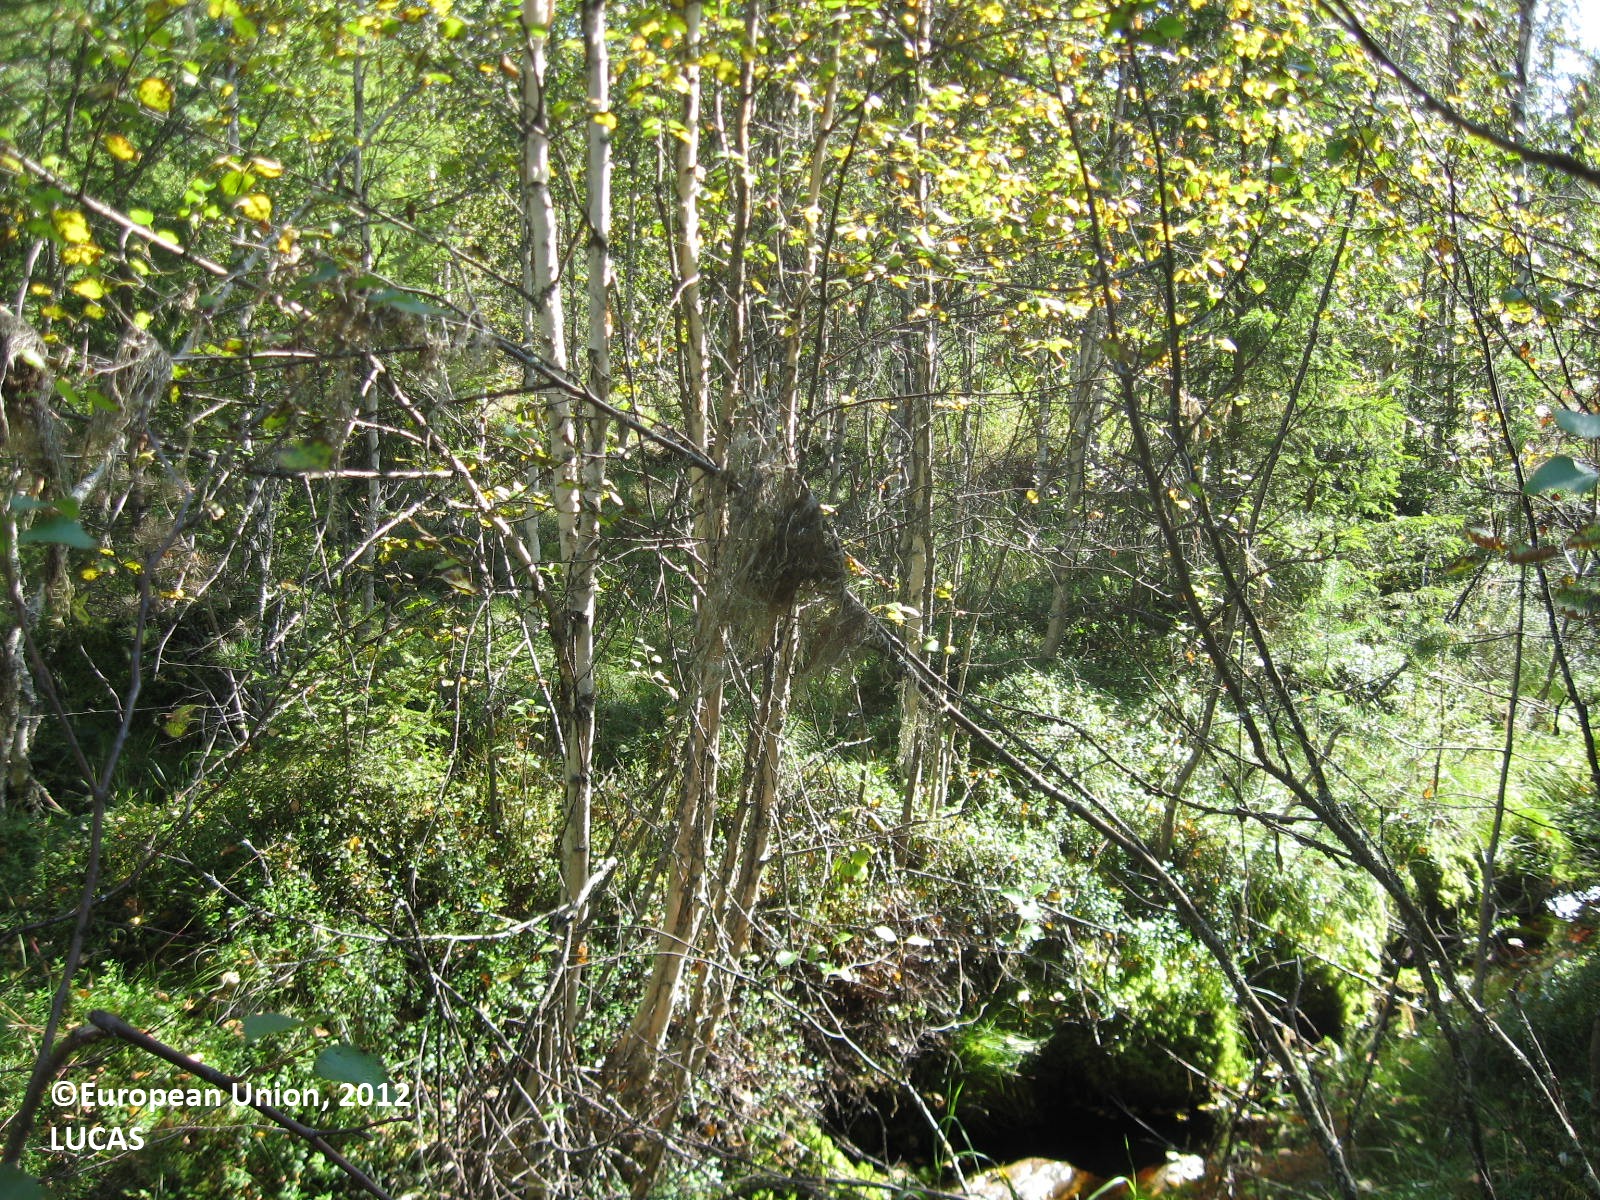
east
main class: Woodland
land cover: Other mixed woodland
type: boreal forest
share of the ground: > 75 %
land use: Forestry
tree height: > 5 m
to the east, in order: Other mixed woodland; Ditches and canals; Other mixed woodland; Ditches and canals; Grass margins; Paved roads, cycling and walking lanes; Grass margins; Ditches and canals; Other coniferous woodland; Ditches and canals; Other coniferous woodland; Pine dominated coniferous woodland; Ditches and canals; Other coniferous woodland; Ditches and canals; Other coniferous woodland
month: August
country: FI
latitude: 63.8560
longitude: 28.6392
